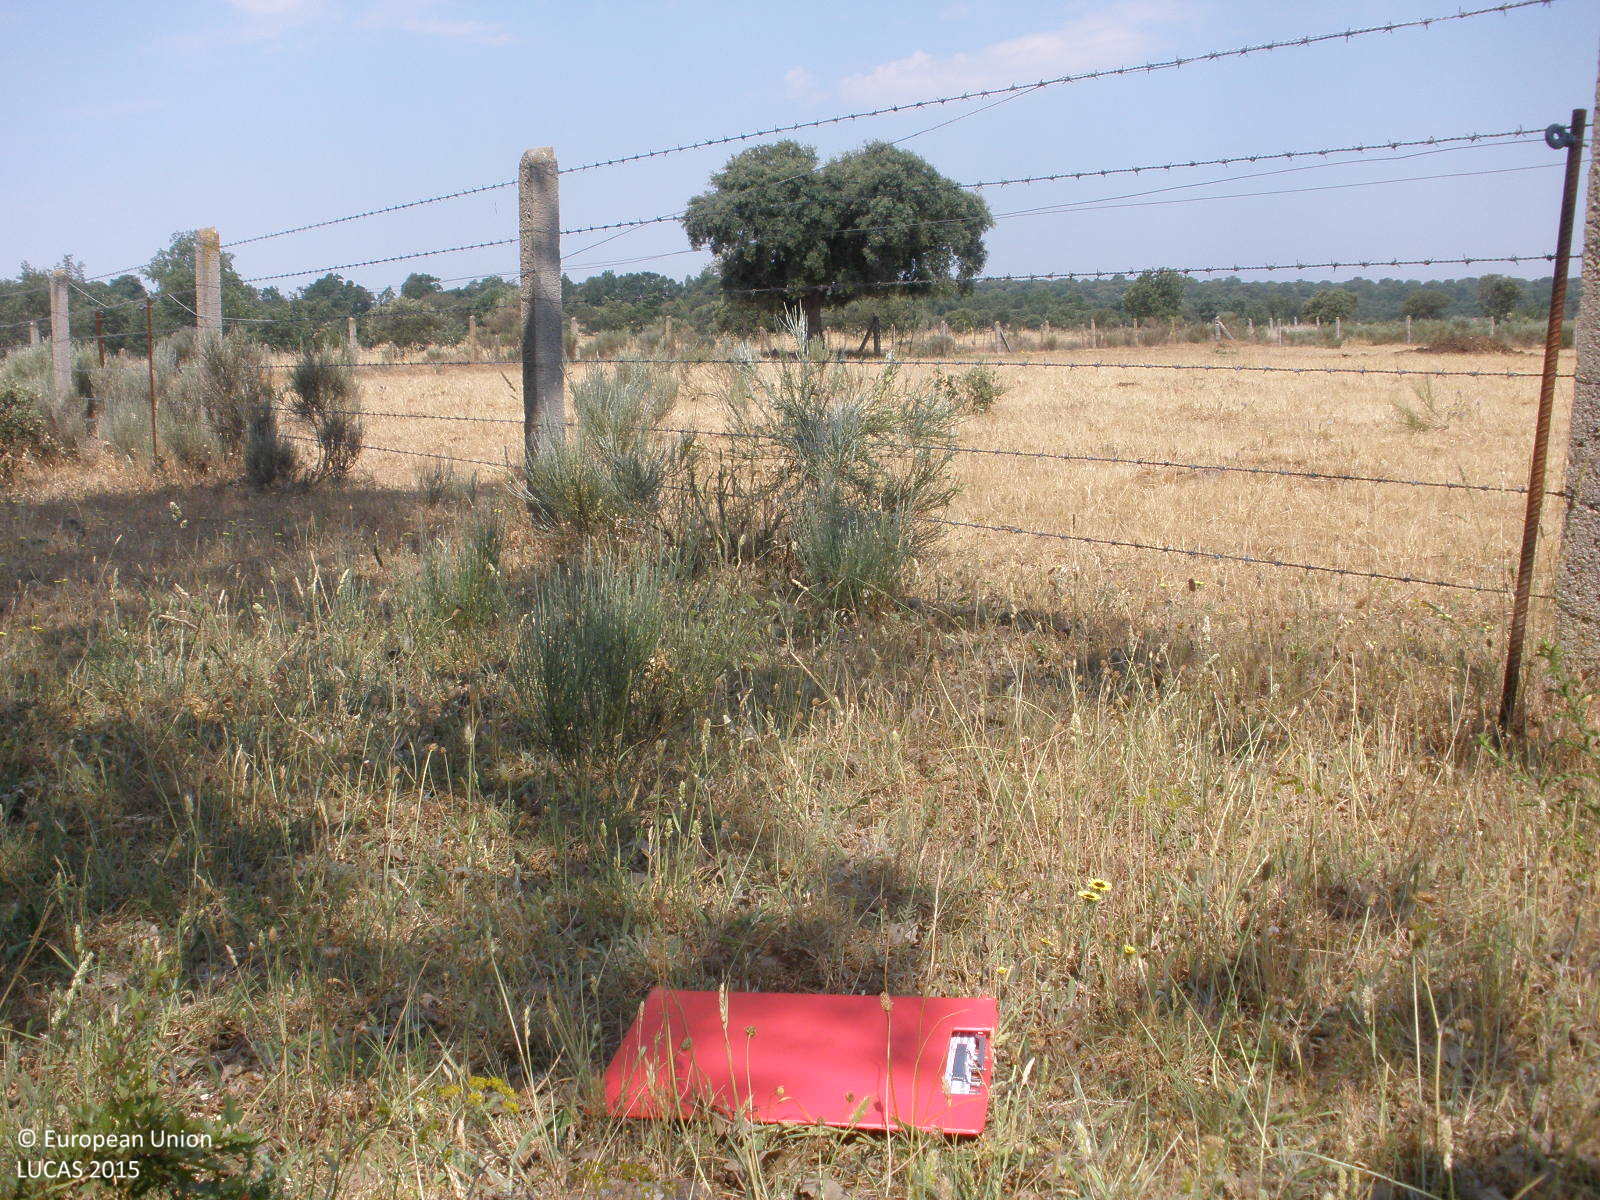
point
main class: Woodland
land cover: Broadleaved woodland
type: thermophilous deciduous forest
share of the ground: > 75 %
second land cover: Grassland without tree/shrub cover
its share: > 75 %
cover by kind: broadleaved forest trees 60 %, herbaceous plants 30 %, shrubs 10 %
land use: Forestry
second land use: Agriculture (excluding fallow land and kitchen gardens)
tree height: > 5 m
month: June
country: ES
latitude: 40.6099
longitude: -6.3853
